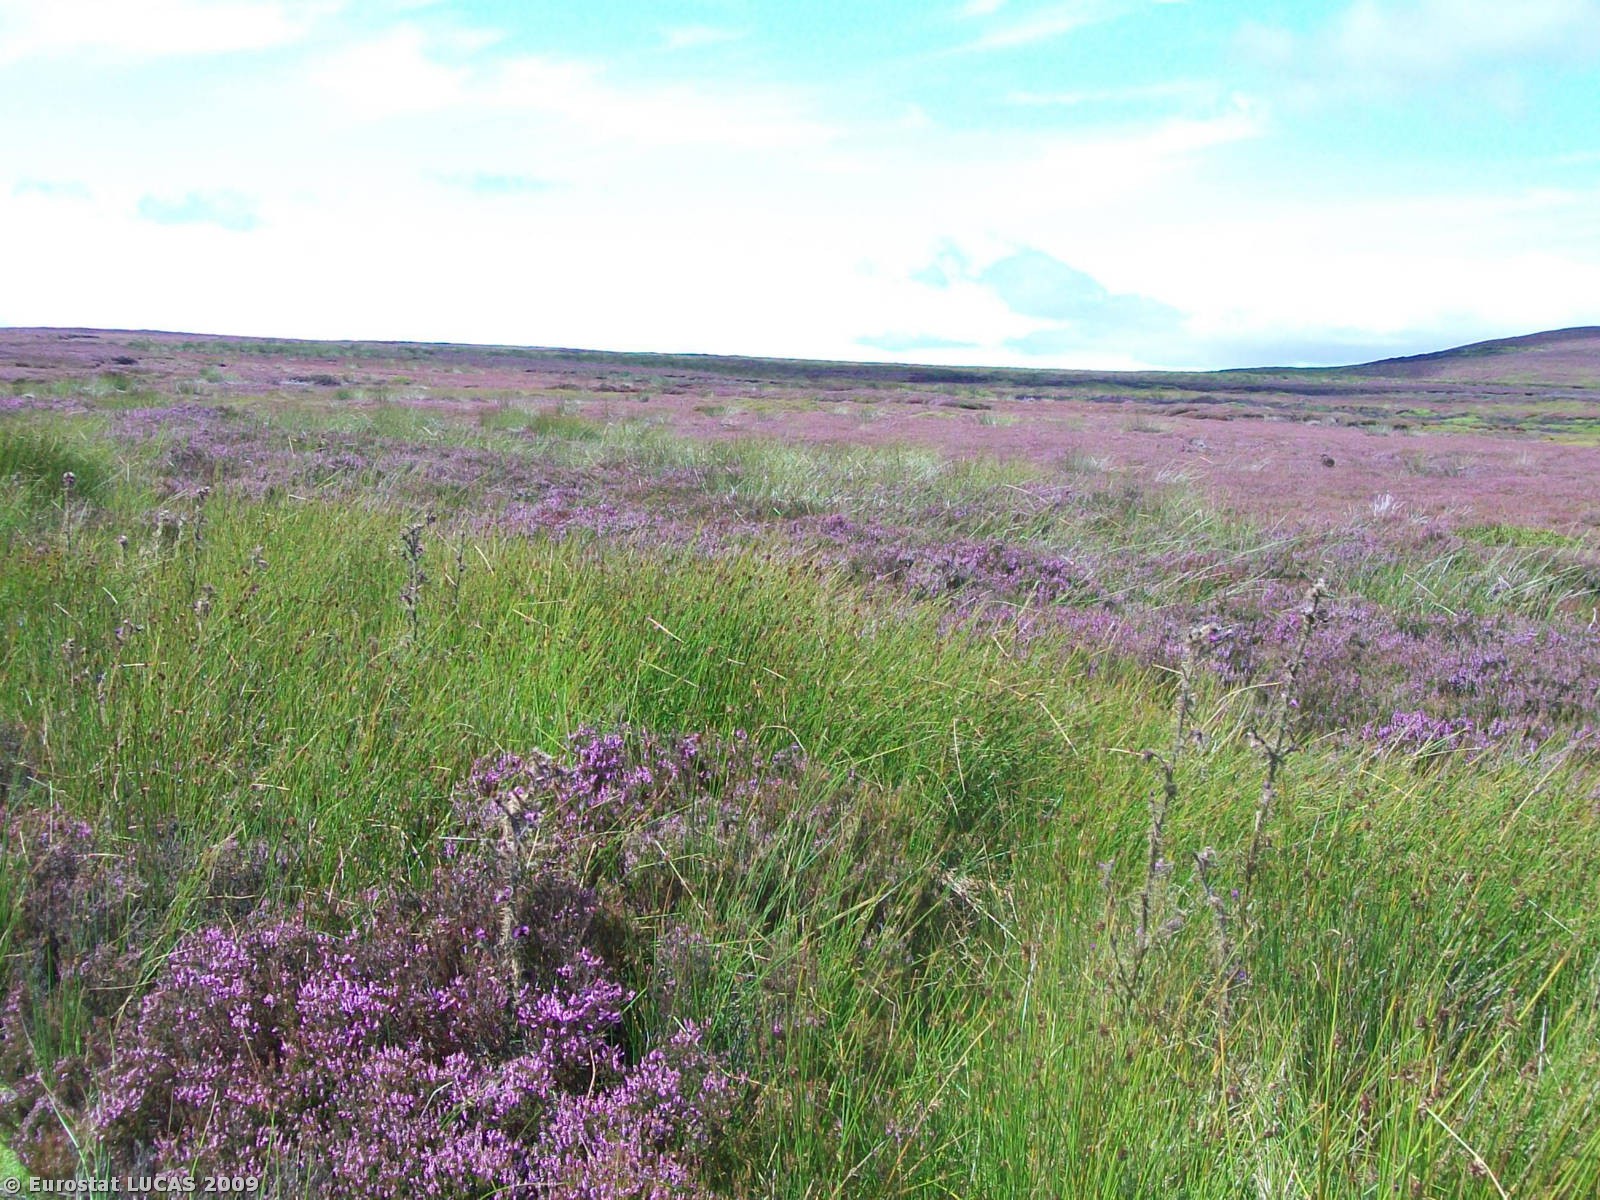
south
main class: Shrubland
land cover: Shrubland without tree cover
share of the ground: > 75 %
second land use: Nature reserves
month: August
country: GB
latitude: 54.1530
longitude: -1.7665
